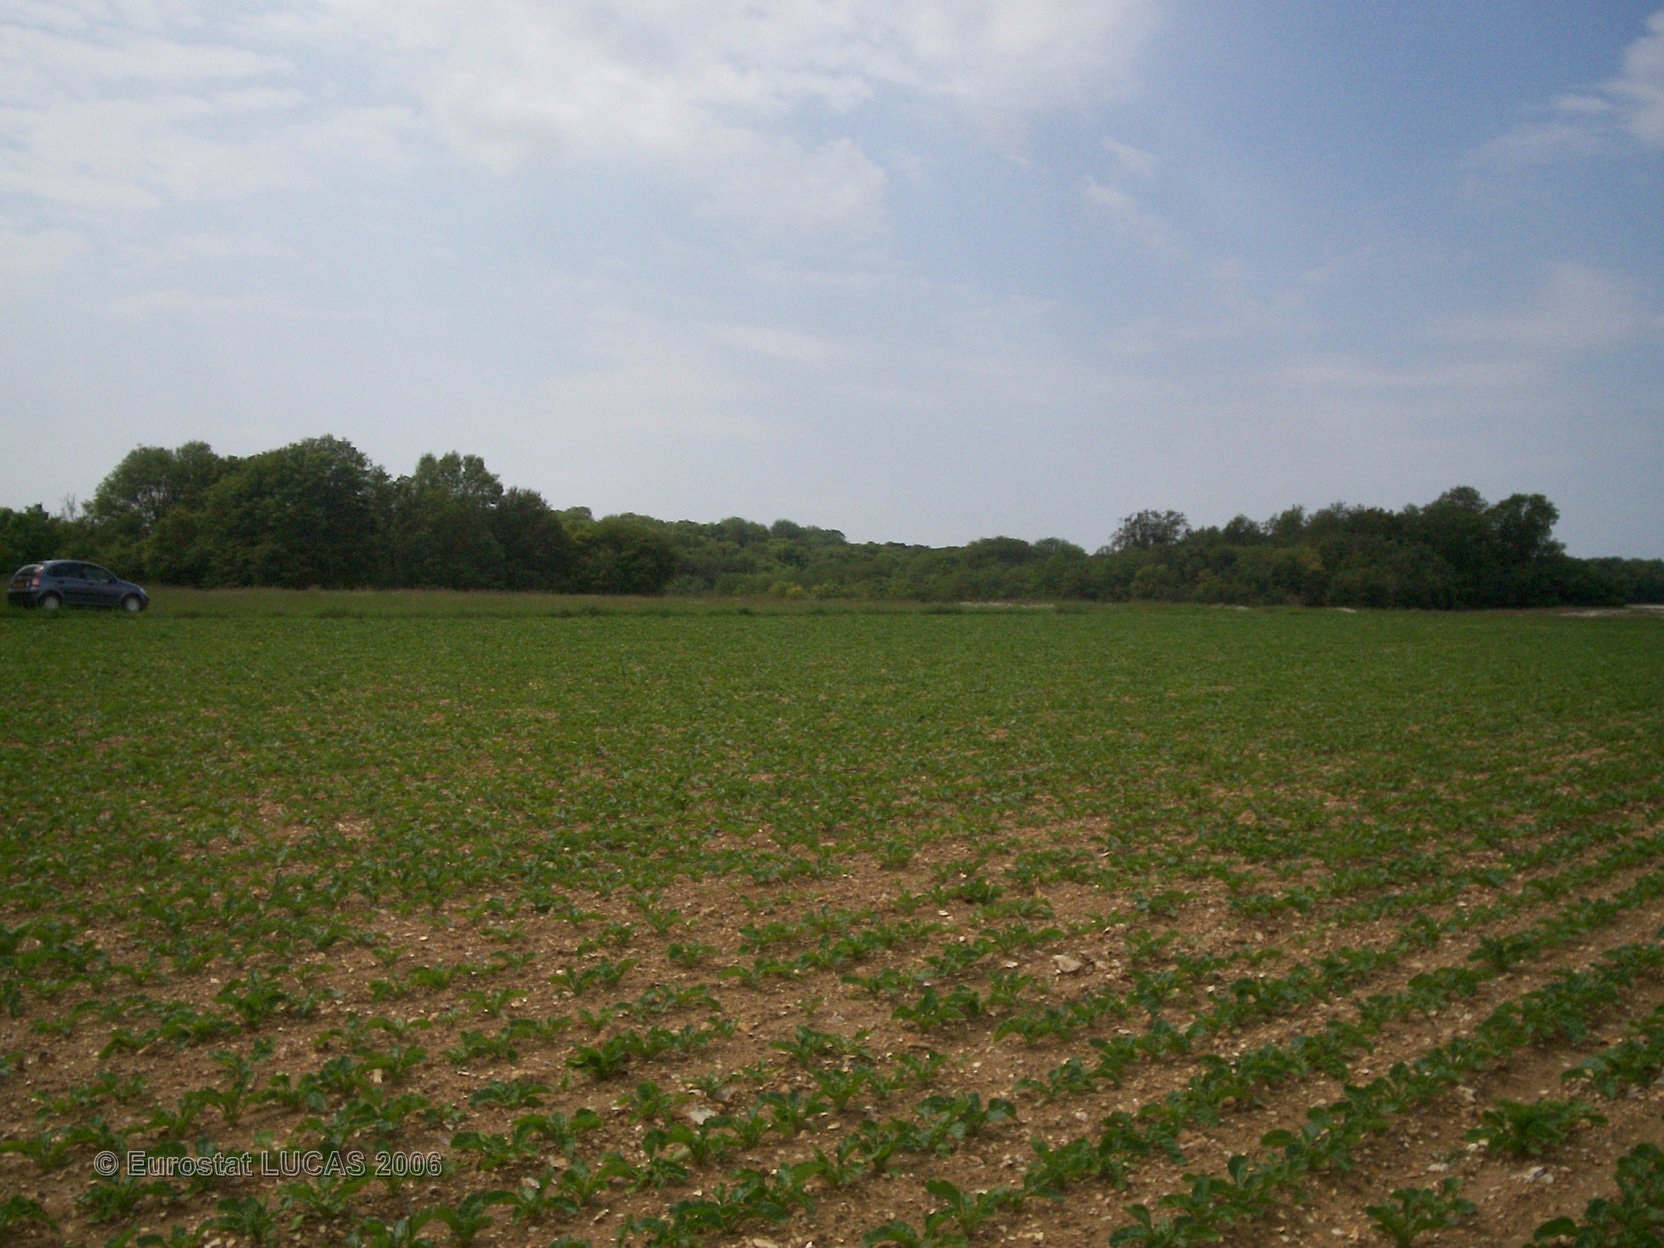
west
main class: Cropland
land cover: Sugar beet
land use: Agriculture (excluding fallow land and kitchen gardens)
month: June
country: FR
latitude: 49.7283
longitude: 2.6220
